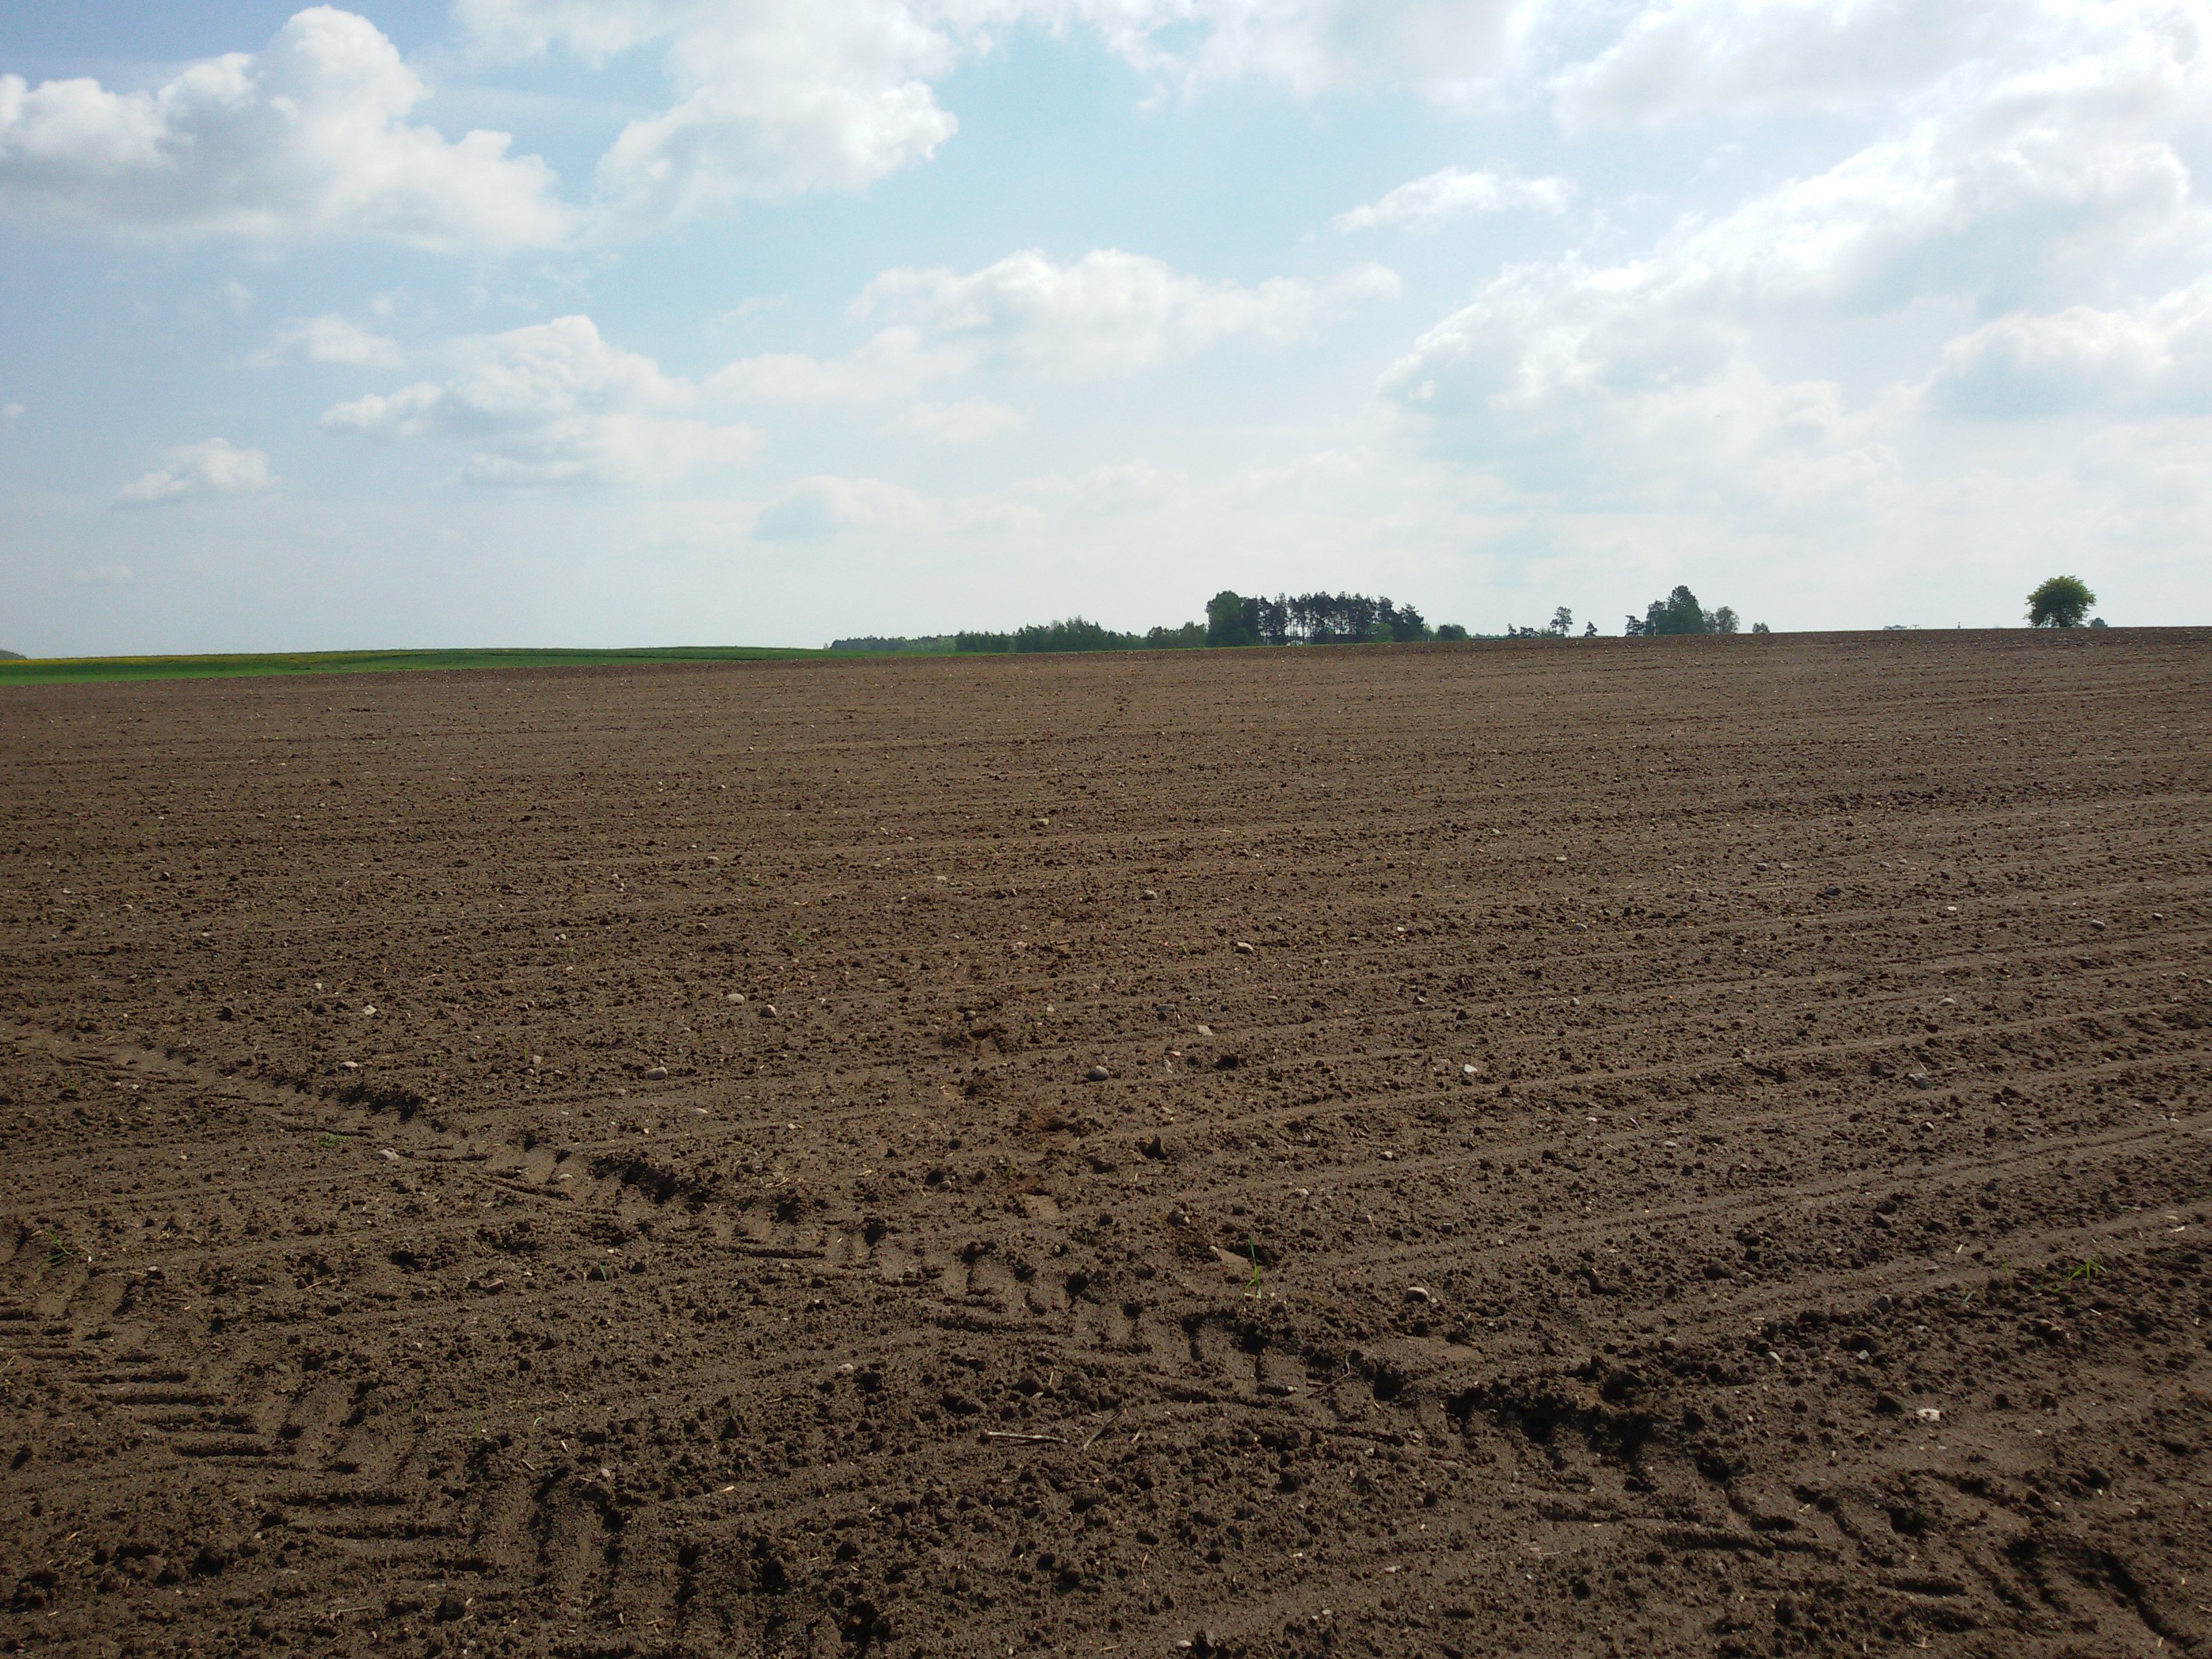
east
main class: Cropland
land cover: Maize
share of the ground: < 10 %
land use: Agriculture (excluding fallow land and kitchen gardens)
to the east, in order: Maize; Oats; Grass margins; Tracks; Grass margins; Common wheat
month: May
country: PL
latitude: 53.0647
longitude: 22.2842
